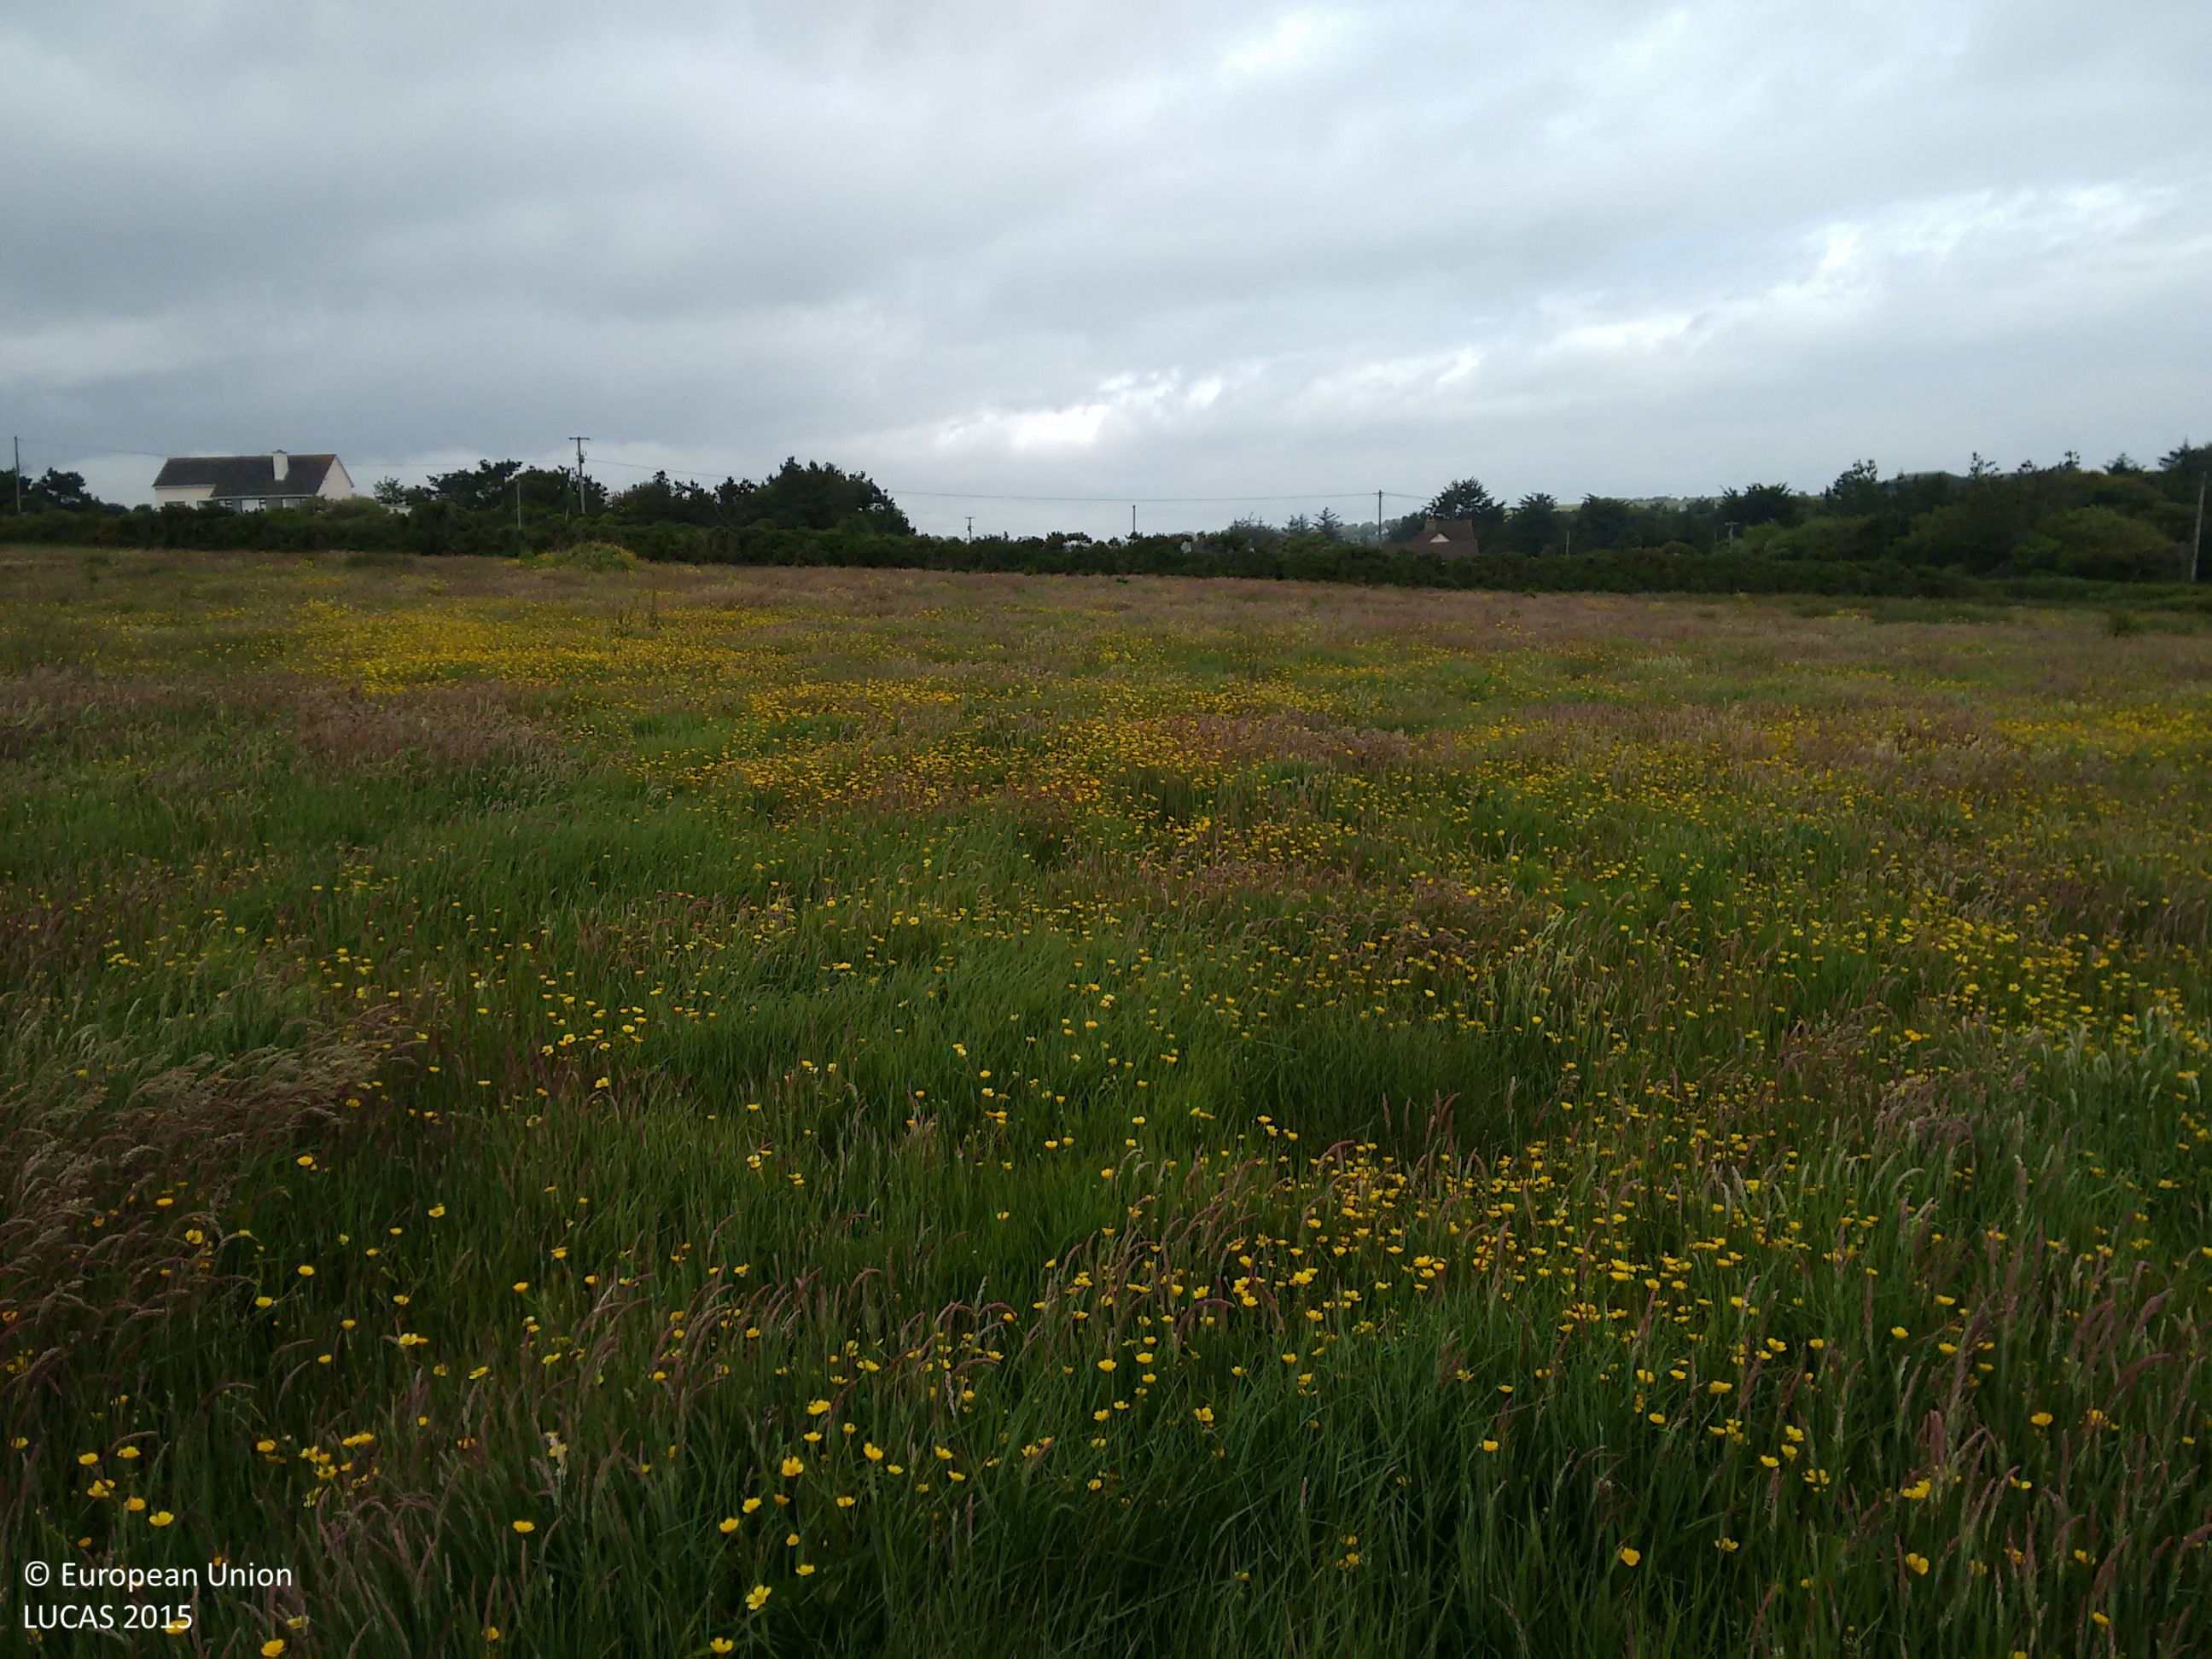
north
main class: Grassland
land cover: Grassland without tree/shrub cover
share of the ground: > 75 %
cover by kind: herbaceous plants 100 %
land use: Agriculture (excluding fallow land and kitchen gardens)
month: June
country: IE
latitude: 52.1388
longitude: -7.2006
